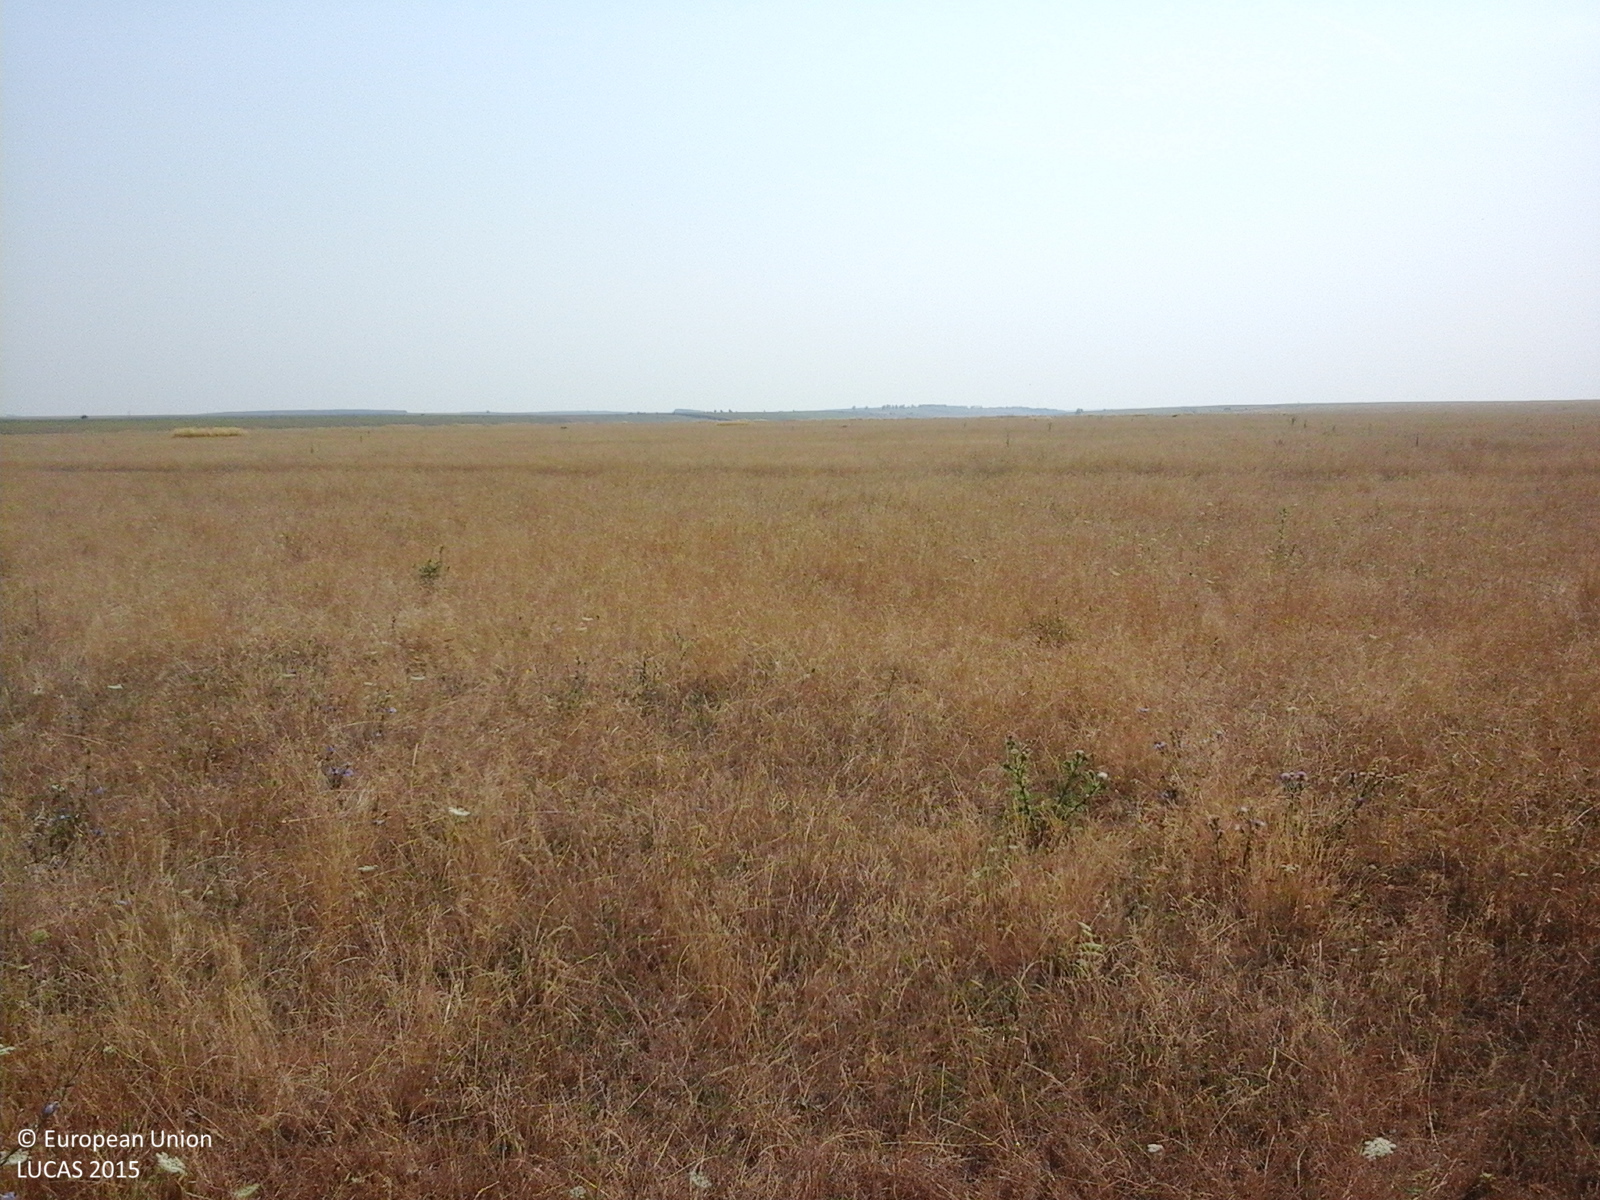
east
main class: Grassland
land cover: Grassland without tree/shrub cover
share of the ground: > 75 %
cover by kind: herbaceous plants 100 %
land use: Agriculture (excluding fallow land and kitchen gardens)
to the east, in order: Grassland without tree/shrub cover; Tracks; Grassland without tree/shrub cover
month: August
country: RO
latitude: 44.4194
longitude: 23.1723
